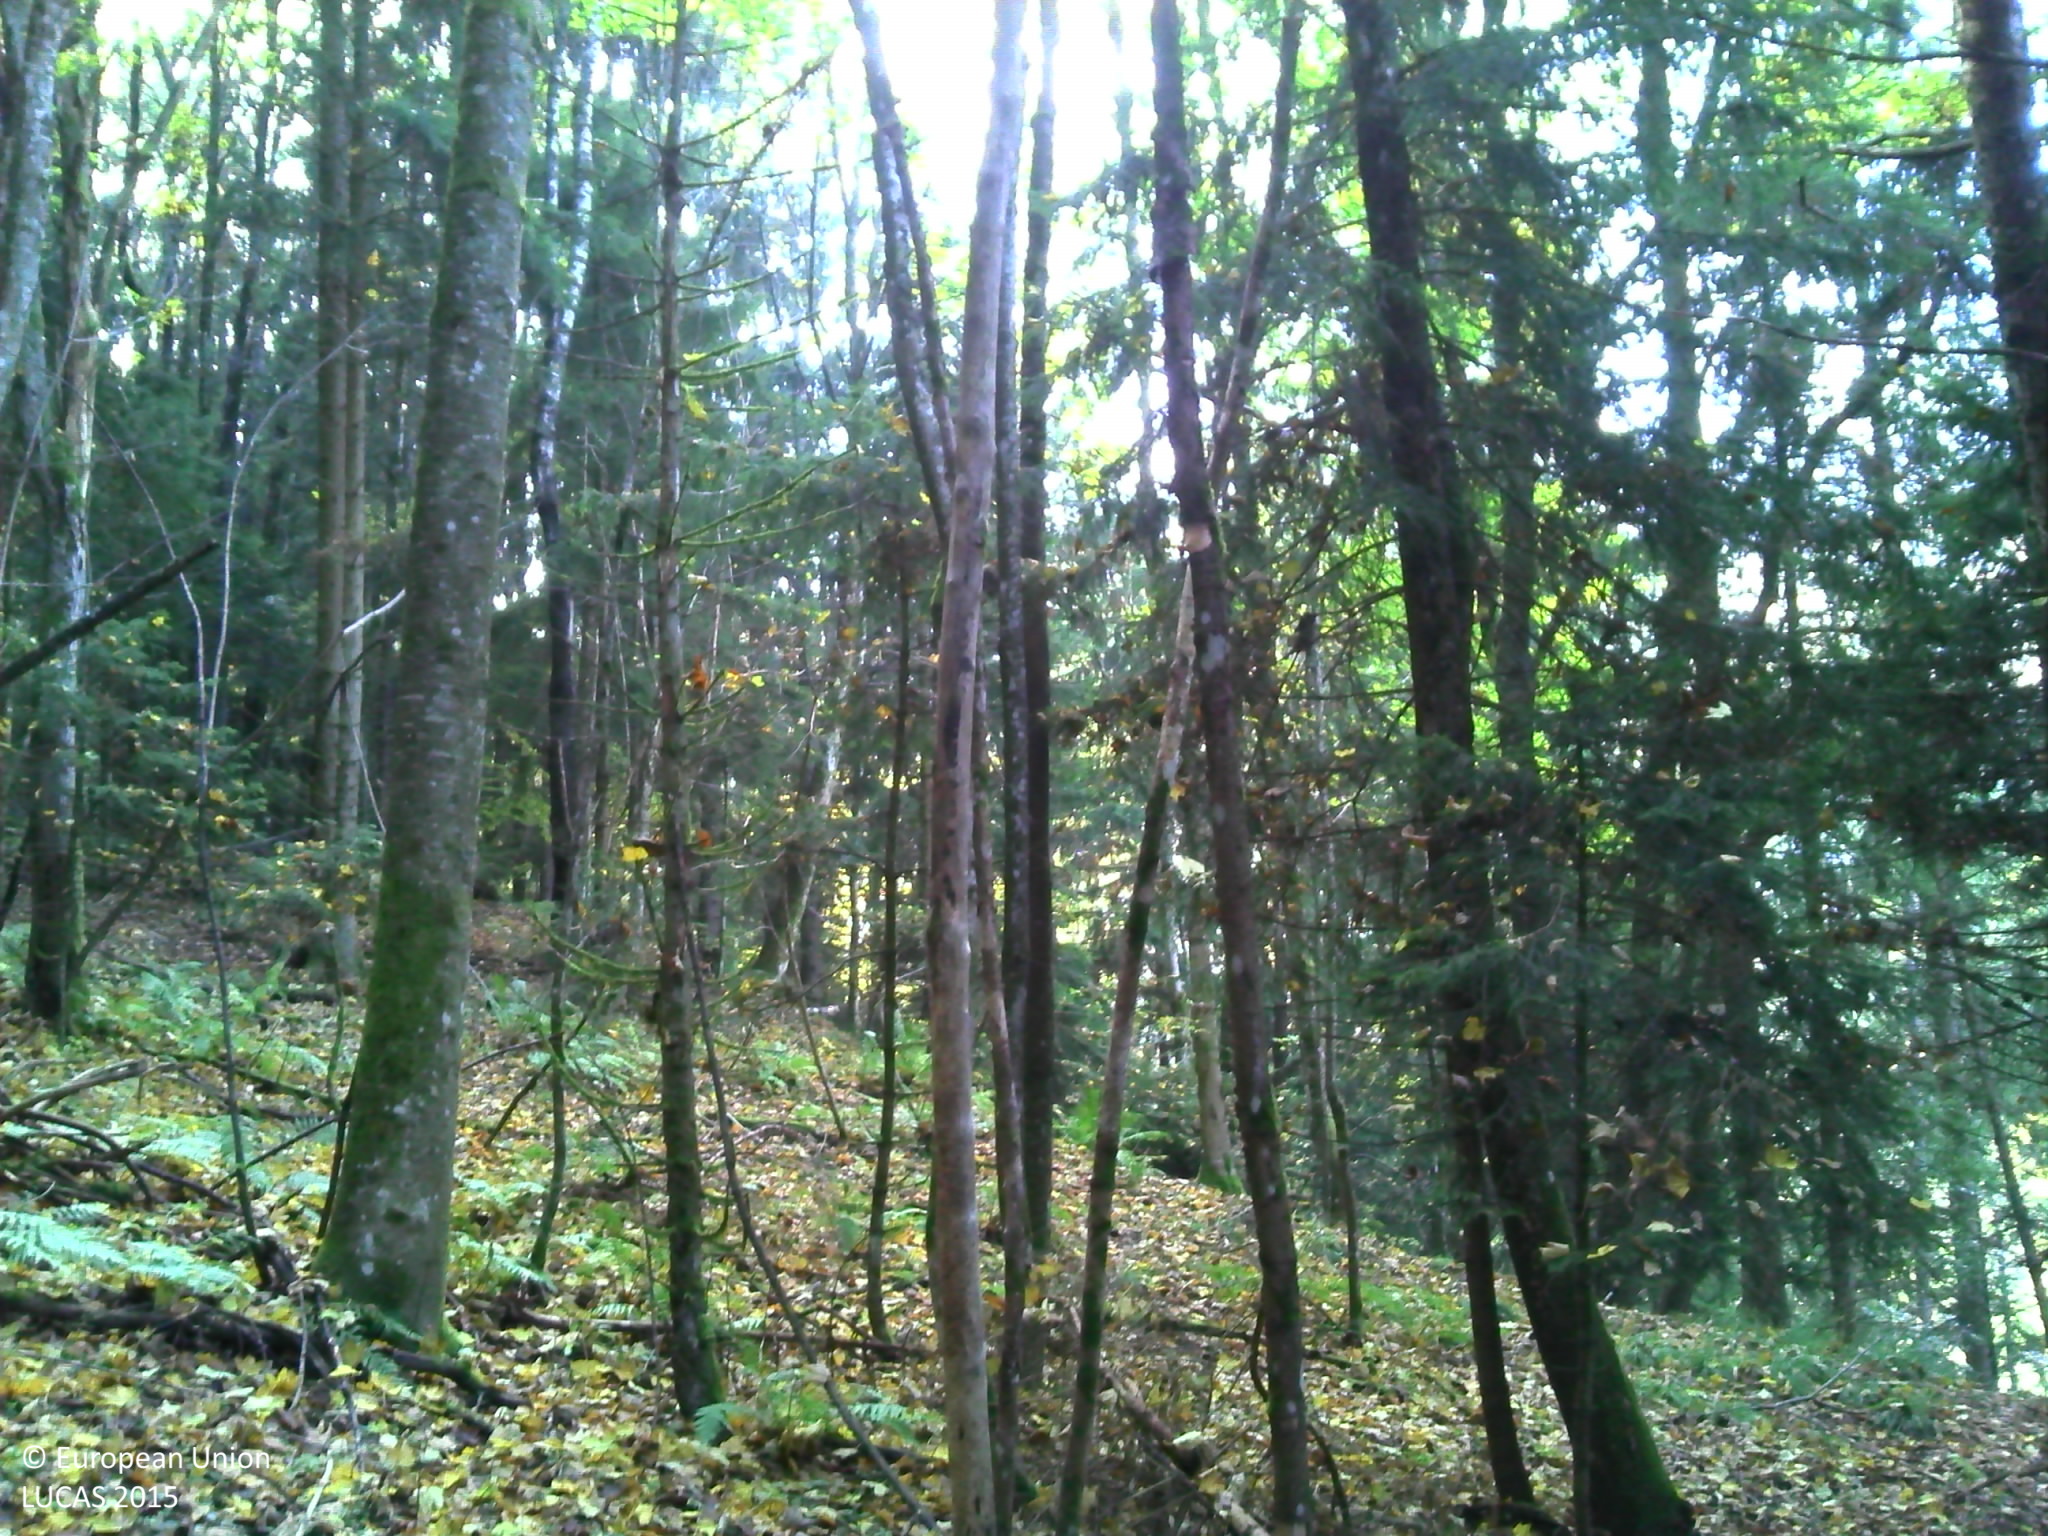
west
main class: Woodland
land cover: Spruce dominated mixed woodland
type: hemiboreal forest and nemoral coniferous forest and mixed broadleaved-coniferous forest
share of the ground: > 75 %
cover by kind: coniferous forest trees 50 %, broadleaved forest trees 35 %, unconsolidated bare surface 15 %
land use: Forestry
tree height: > 5 m
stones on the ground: < 10 %
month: October
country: FR
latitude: 45.4562
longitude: 6.2579
